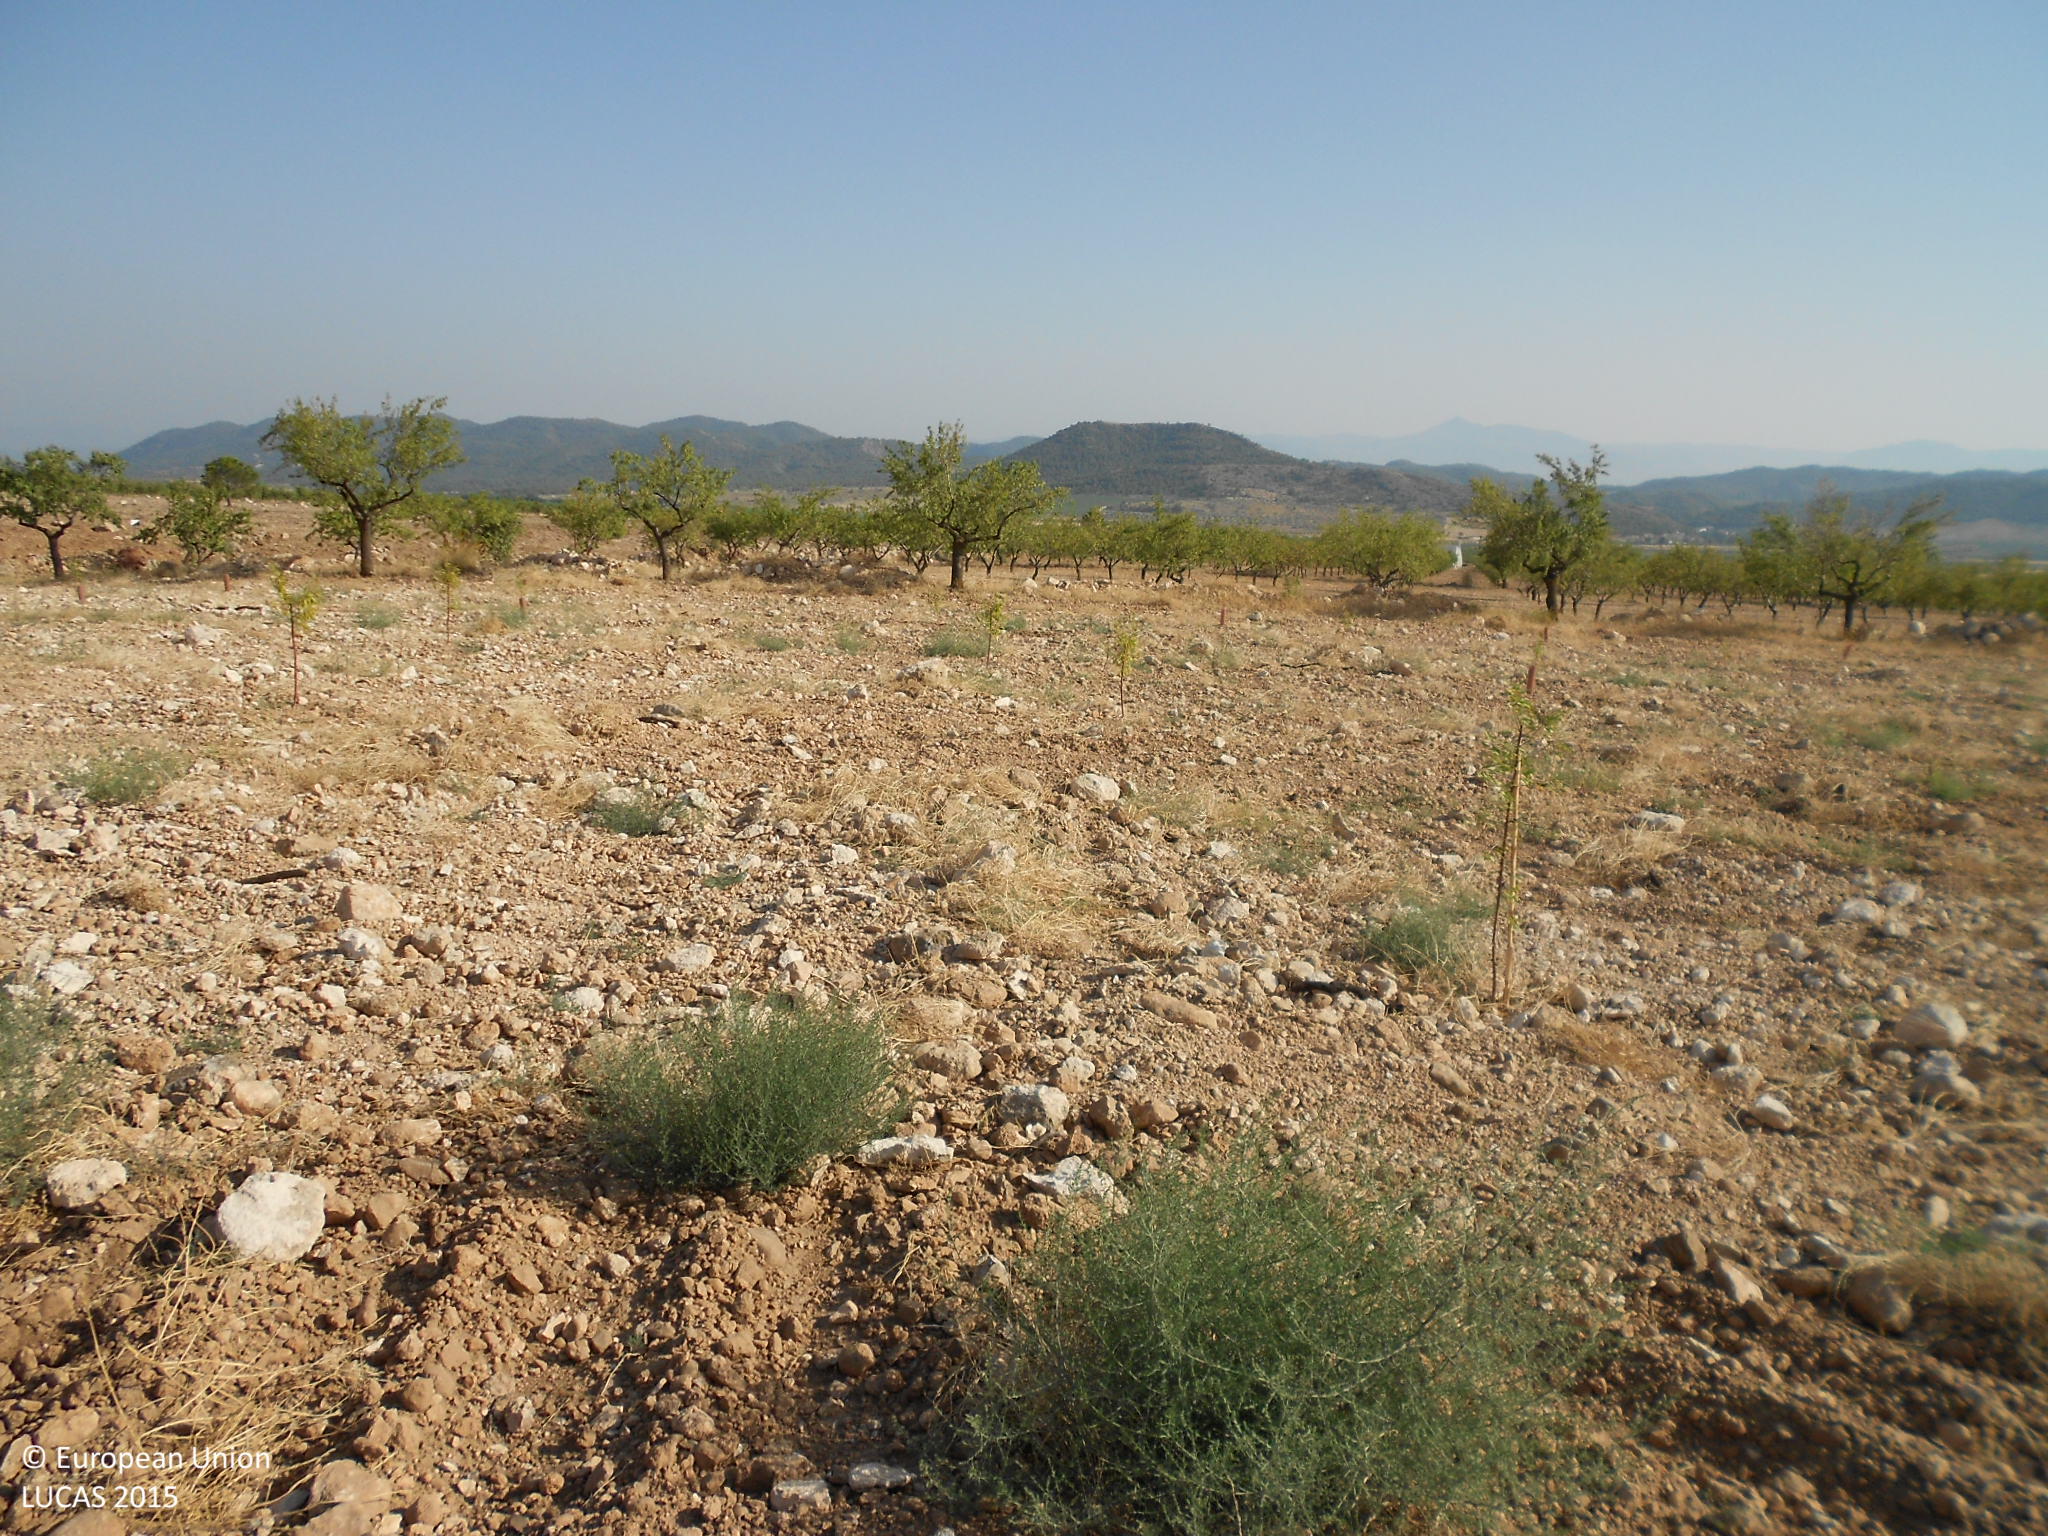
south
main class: Cropland
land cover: Nuts trees
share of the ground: < 10 %
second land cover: Other bare soil
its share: > 75 %
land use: Agriculture (excluding fallow land and kitchen gardens)
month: July
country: ES
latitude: 37.4716
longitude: -2.3425
